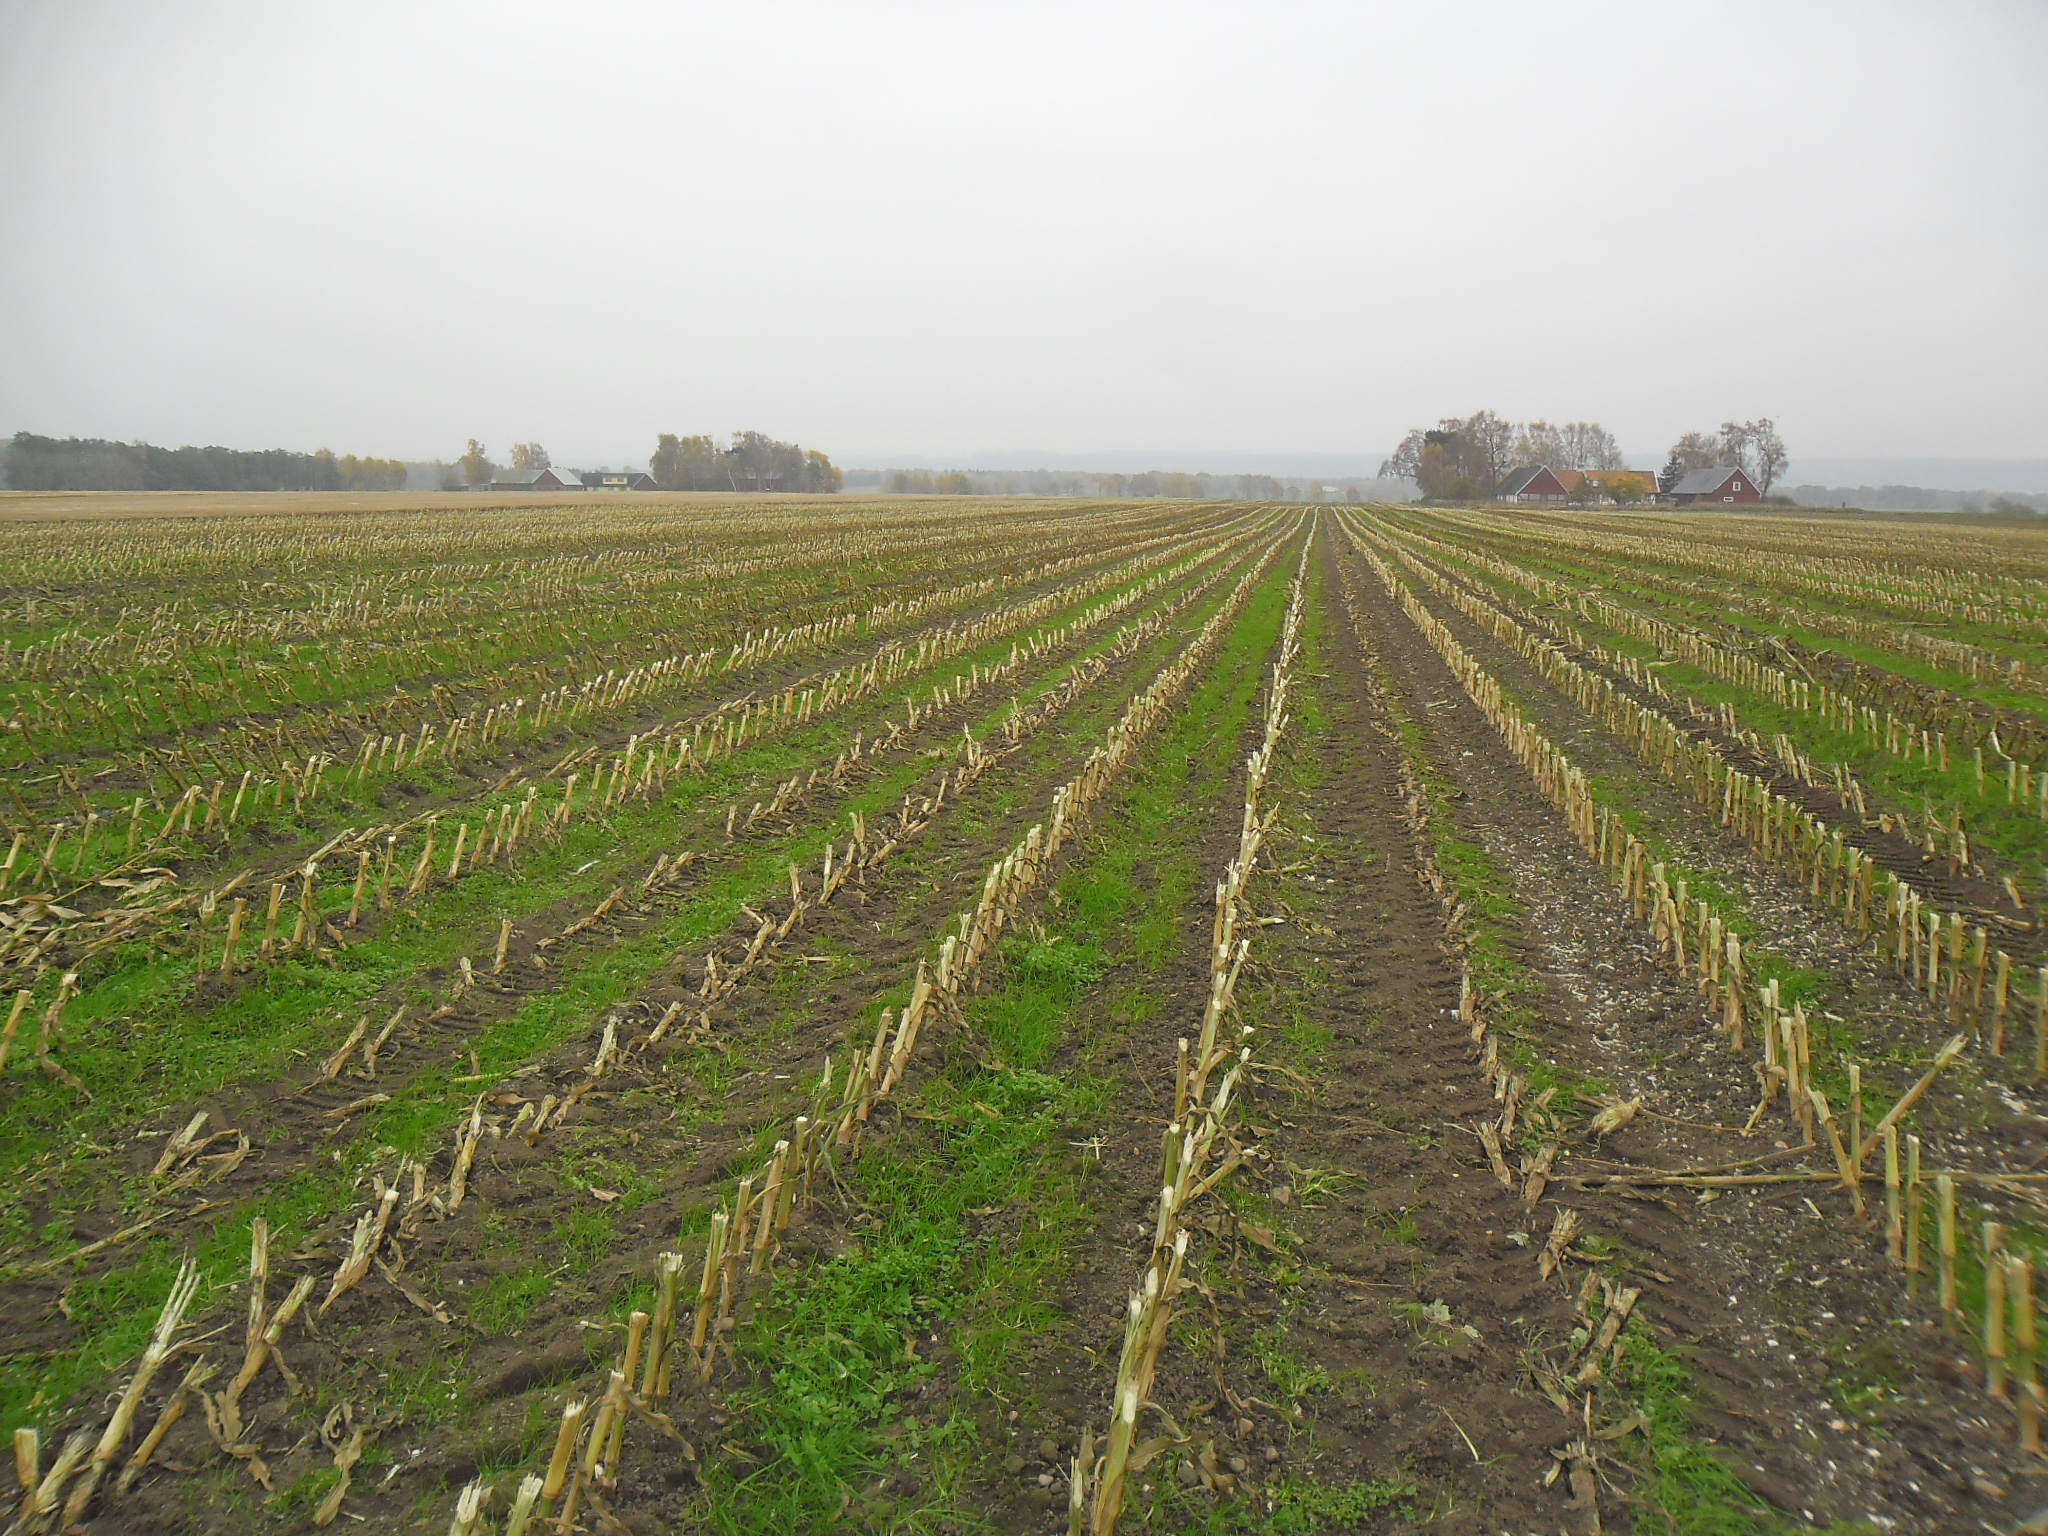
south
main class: Cropland
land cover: Maize
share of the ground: < 10 %
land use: Agriculture (excluding fallow land and kitchen gardens)
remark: Harvested field
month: October
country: SE
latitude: 56.4383
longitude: 13.0949
